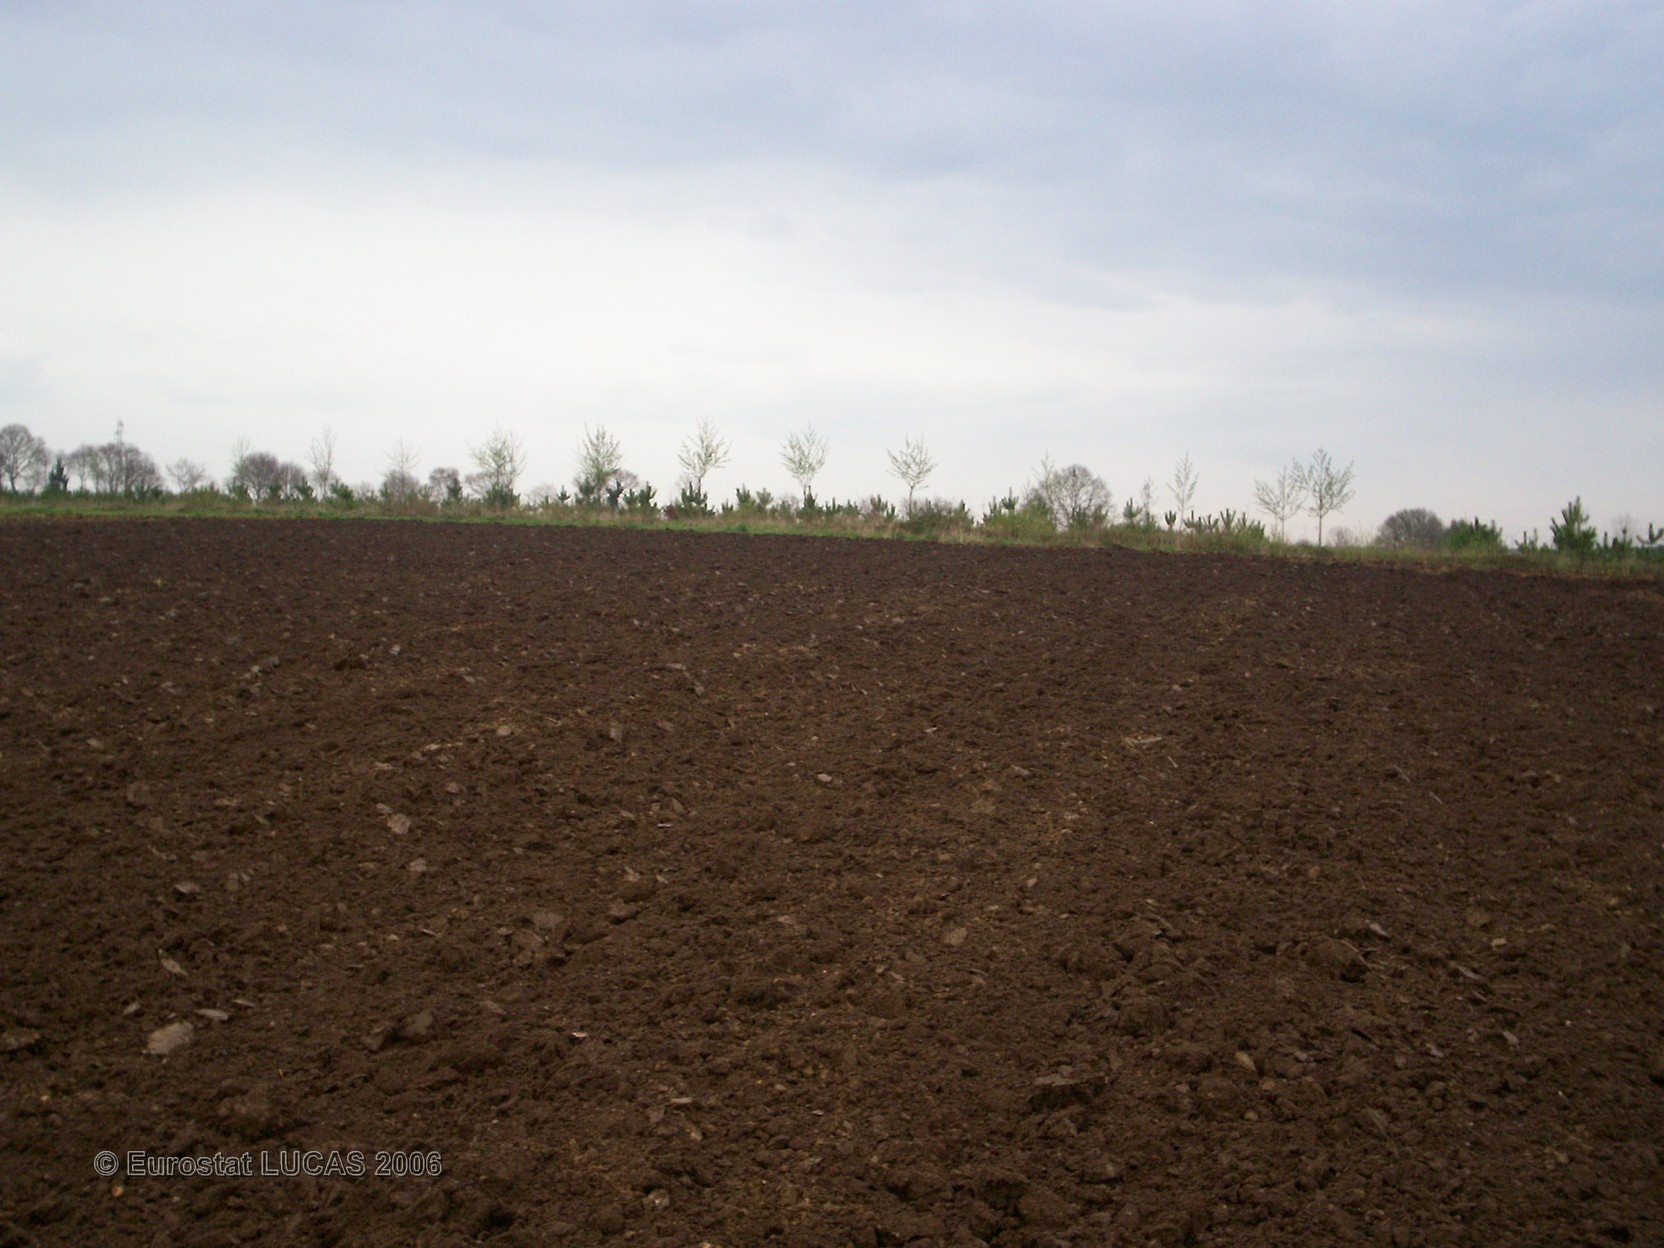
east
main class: Cropland
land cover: Maize
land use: Agriculture (excluding fallow land and kitchen gardens)
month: May
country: FR
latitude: 48.0829
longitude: -2.8862
